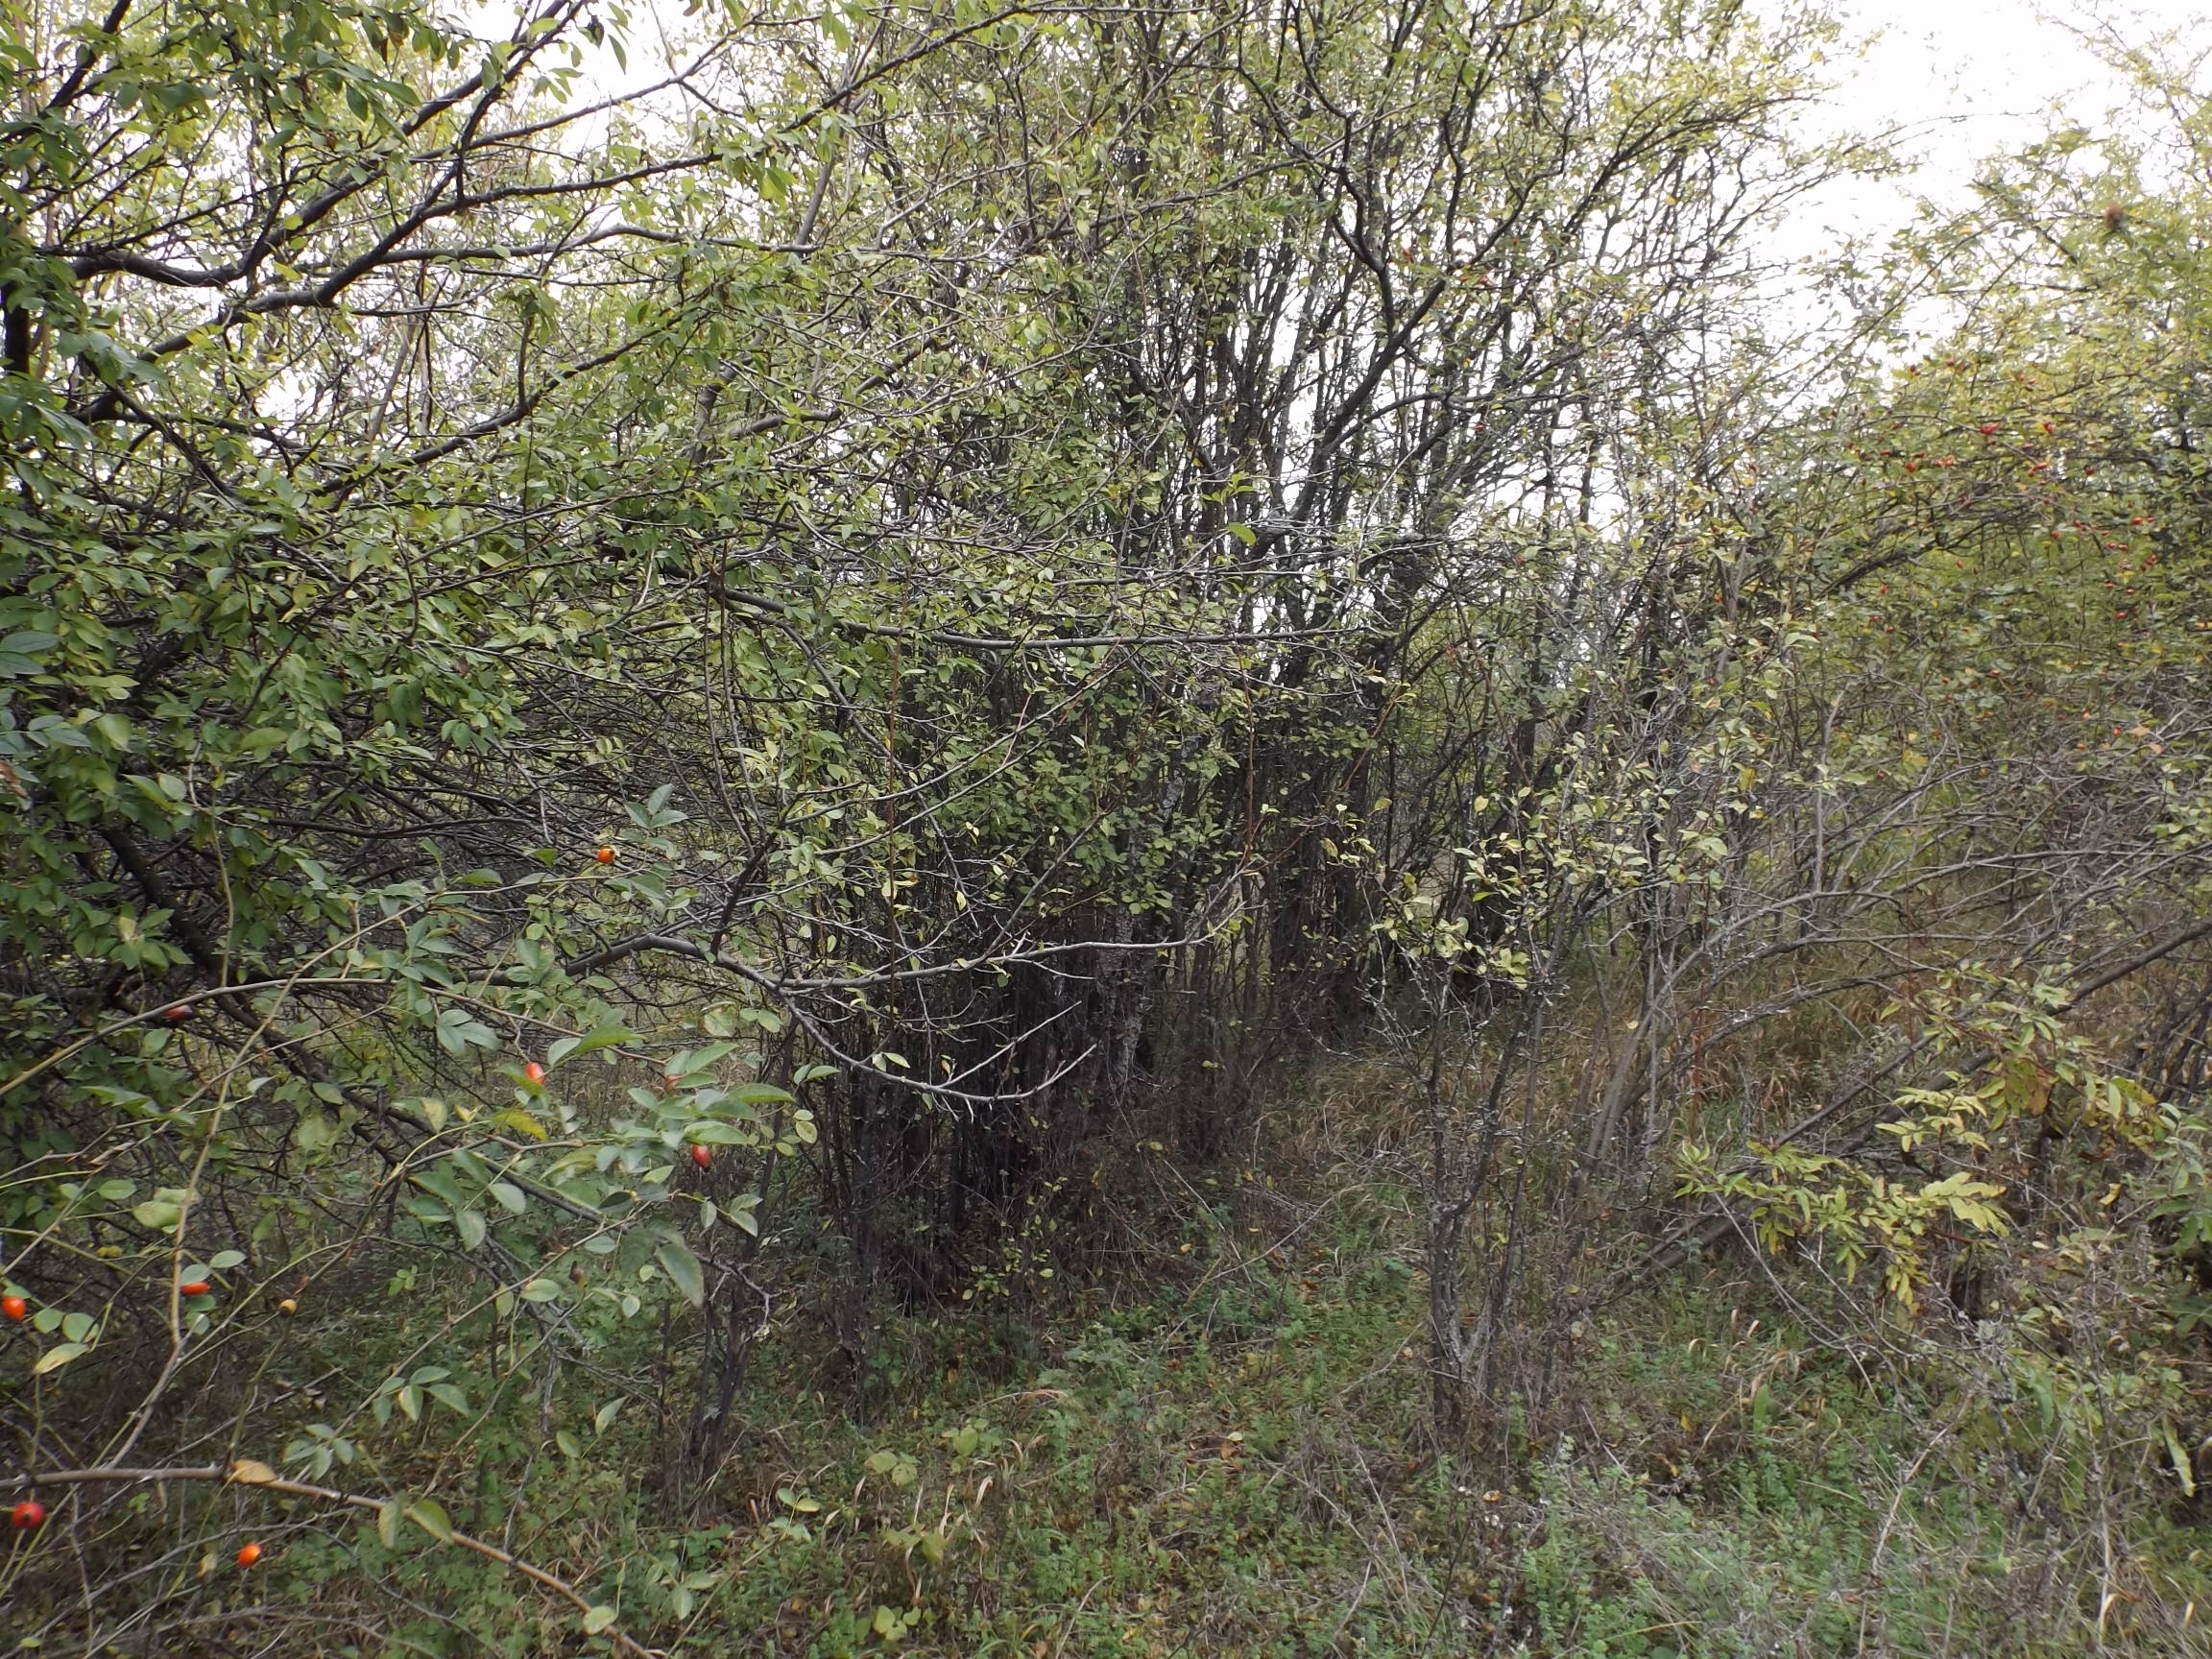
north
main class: Shrubland
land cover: Shrubland with sparse tree cover
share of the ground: > 75 %
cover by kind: shrubs 65 %, herbaceous plants 30 %, broadleaved forest trees 5 %
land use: Semi-natural and natural areas not in use
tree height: > 5 m
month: October
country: BG
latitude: 44.0313
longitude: 26.8263
